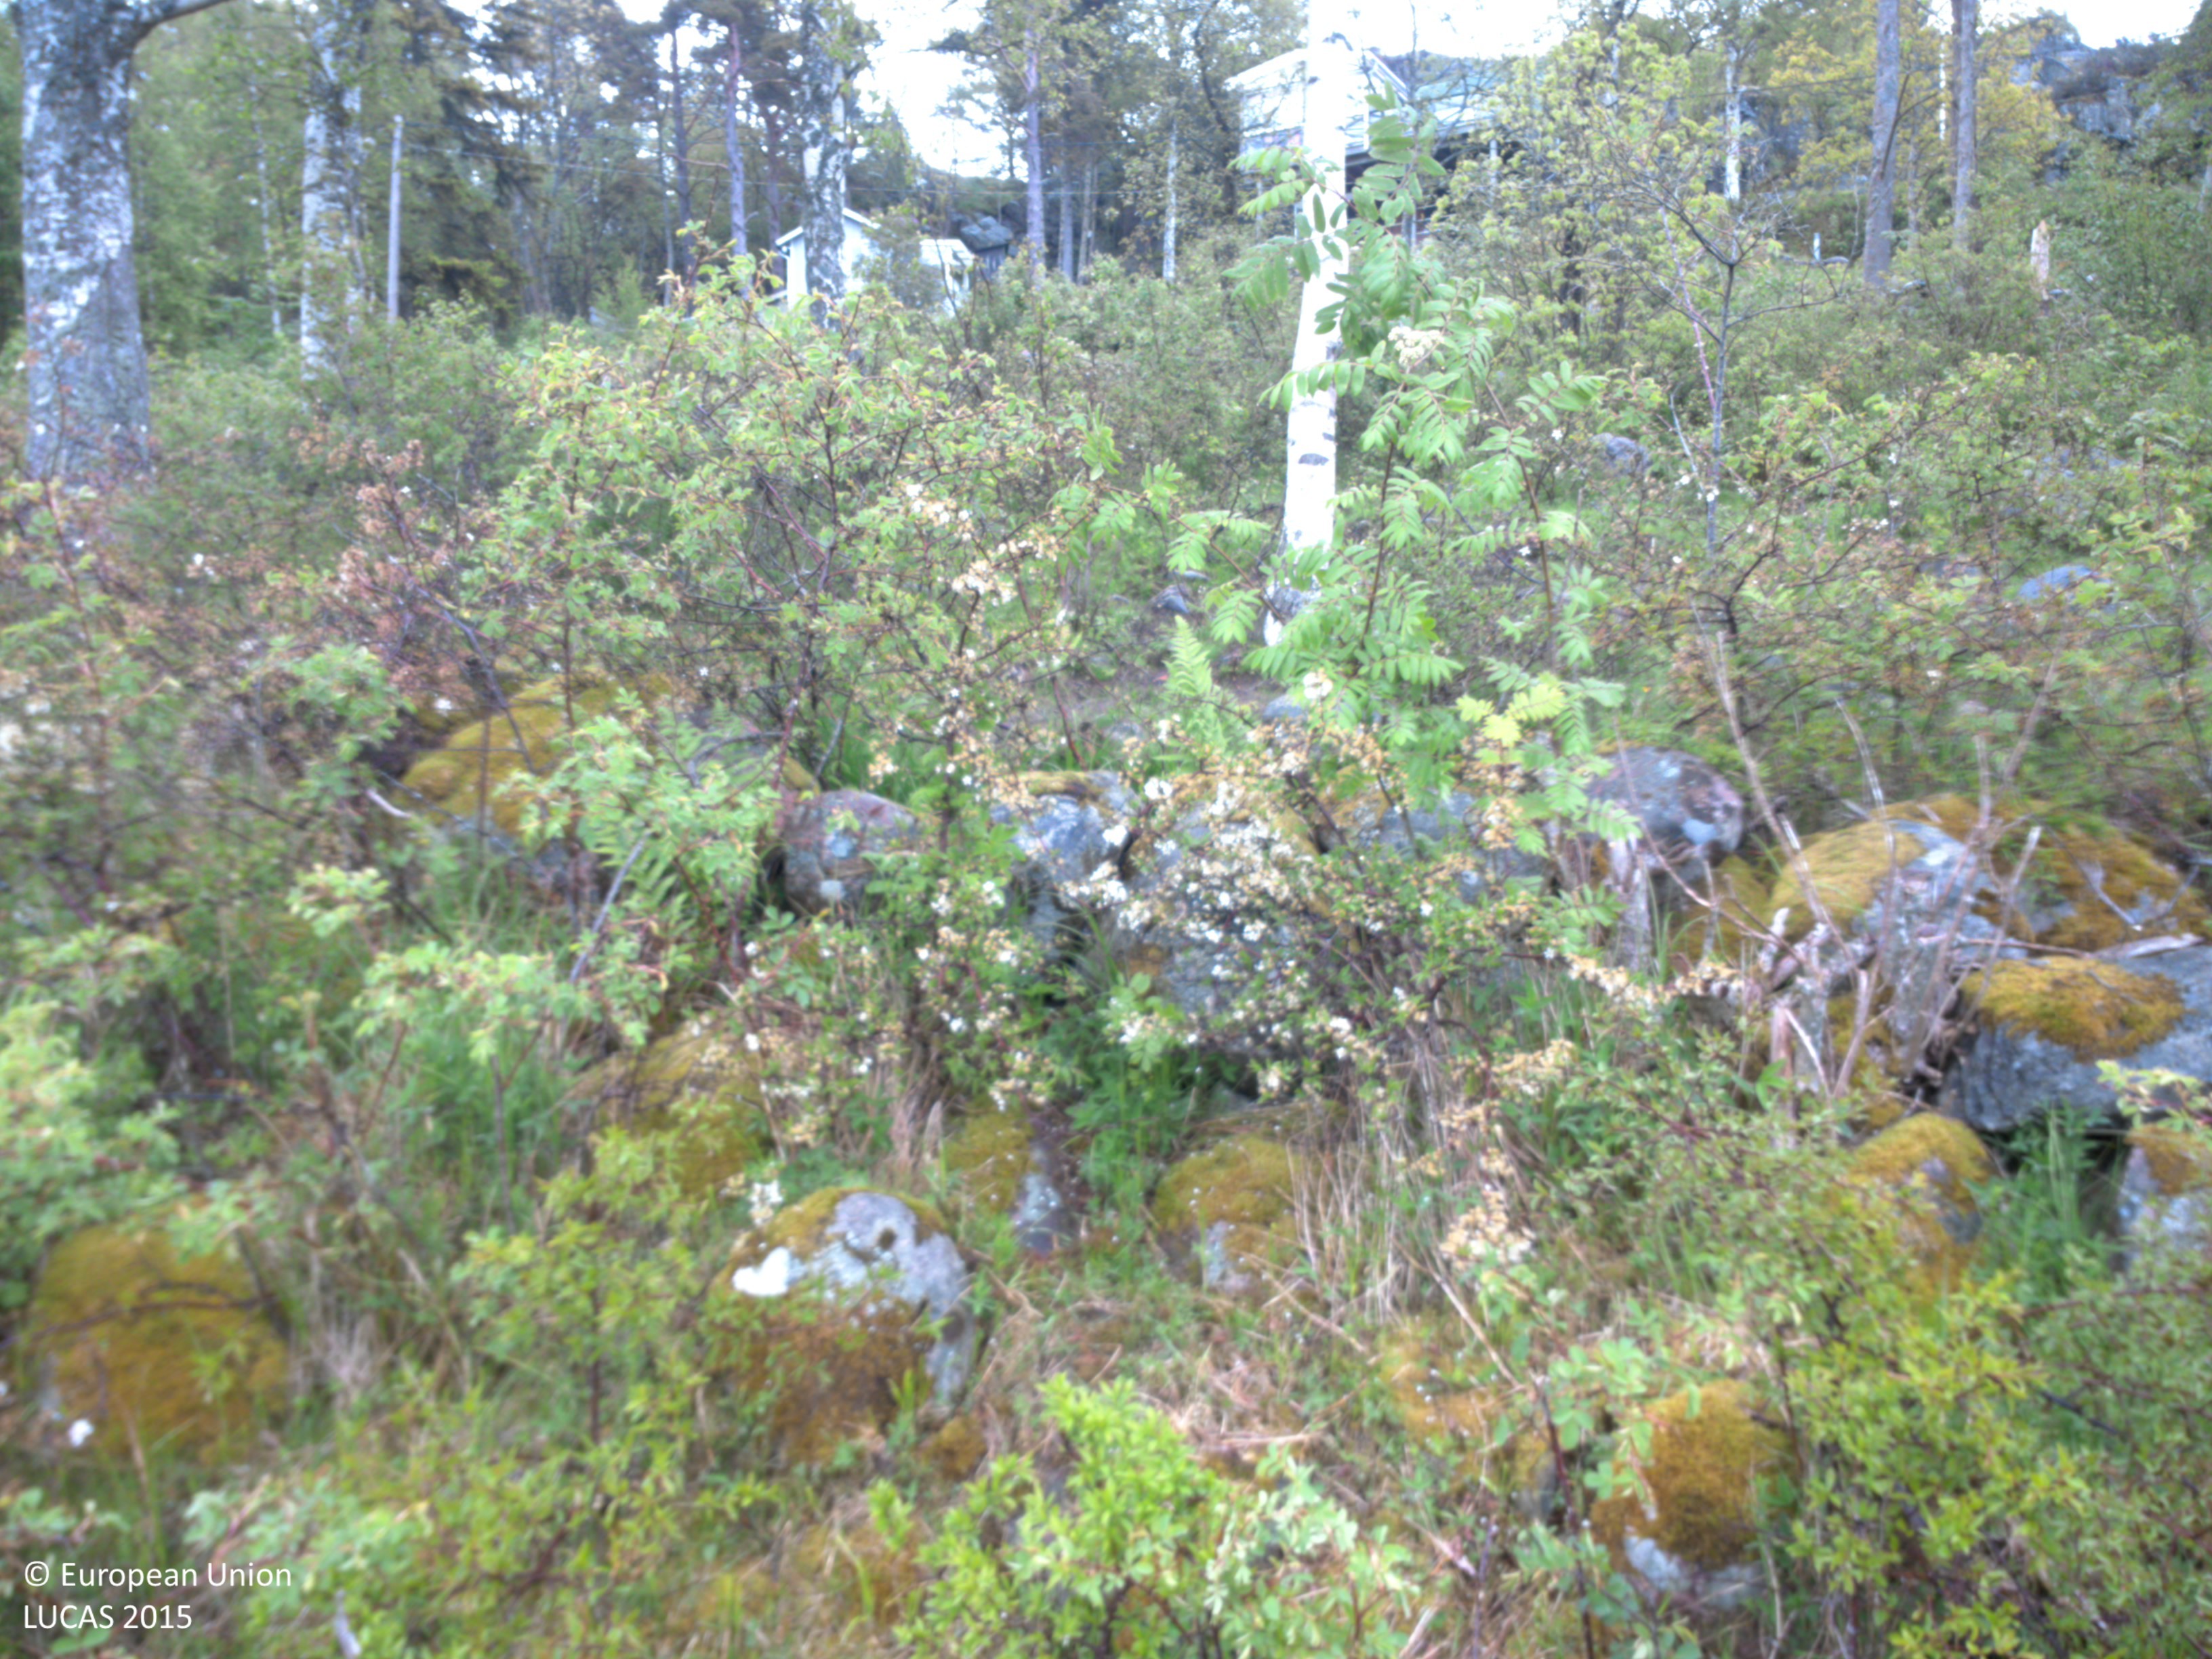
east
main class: Grassland
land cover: Grassland without tree/shrub cover
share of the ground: > 75 %
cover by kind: herbaceous plants 100 %
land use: Agriculture (excluding fallow land and kitchen gardens)
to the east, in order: Grassland without tree/shrub cover; Shruby margins; Dry stone walls; Broadleaved woodland; Dry stone walls; Tracks; Electric lines; Artificial constructions in urban areas; Rocks and stones; Spruce dominated mixed woodland; Tracks; Pine dominated mixed woodland; Inland marshes; Shrubland with sparse tree cover; Electric lines; Broadleaved woodland; Grassland with sparse tree/shrub cover
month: May
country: SE
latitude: 58.3361
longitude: 11.5852
